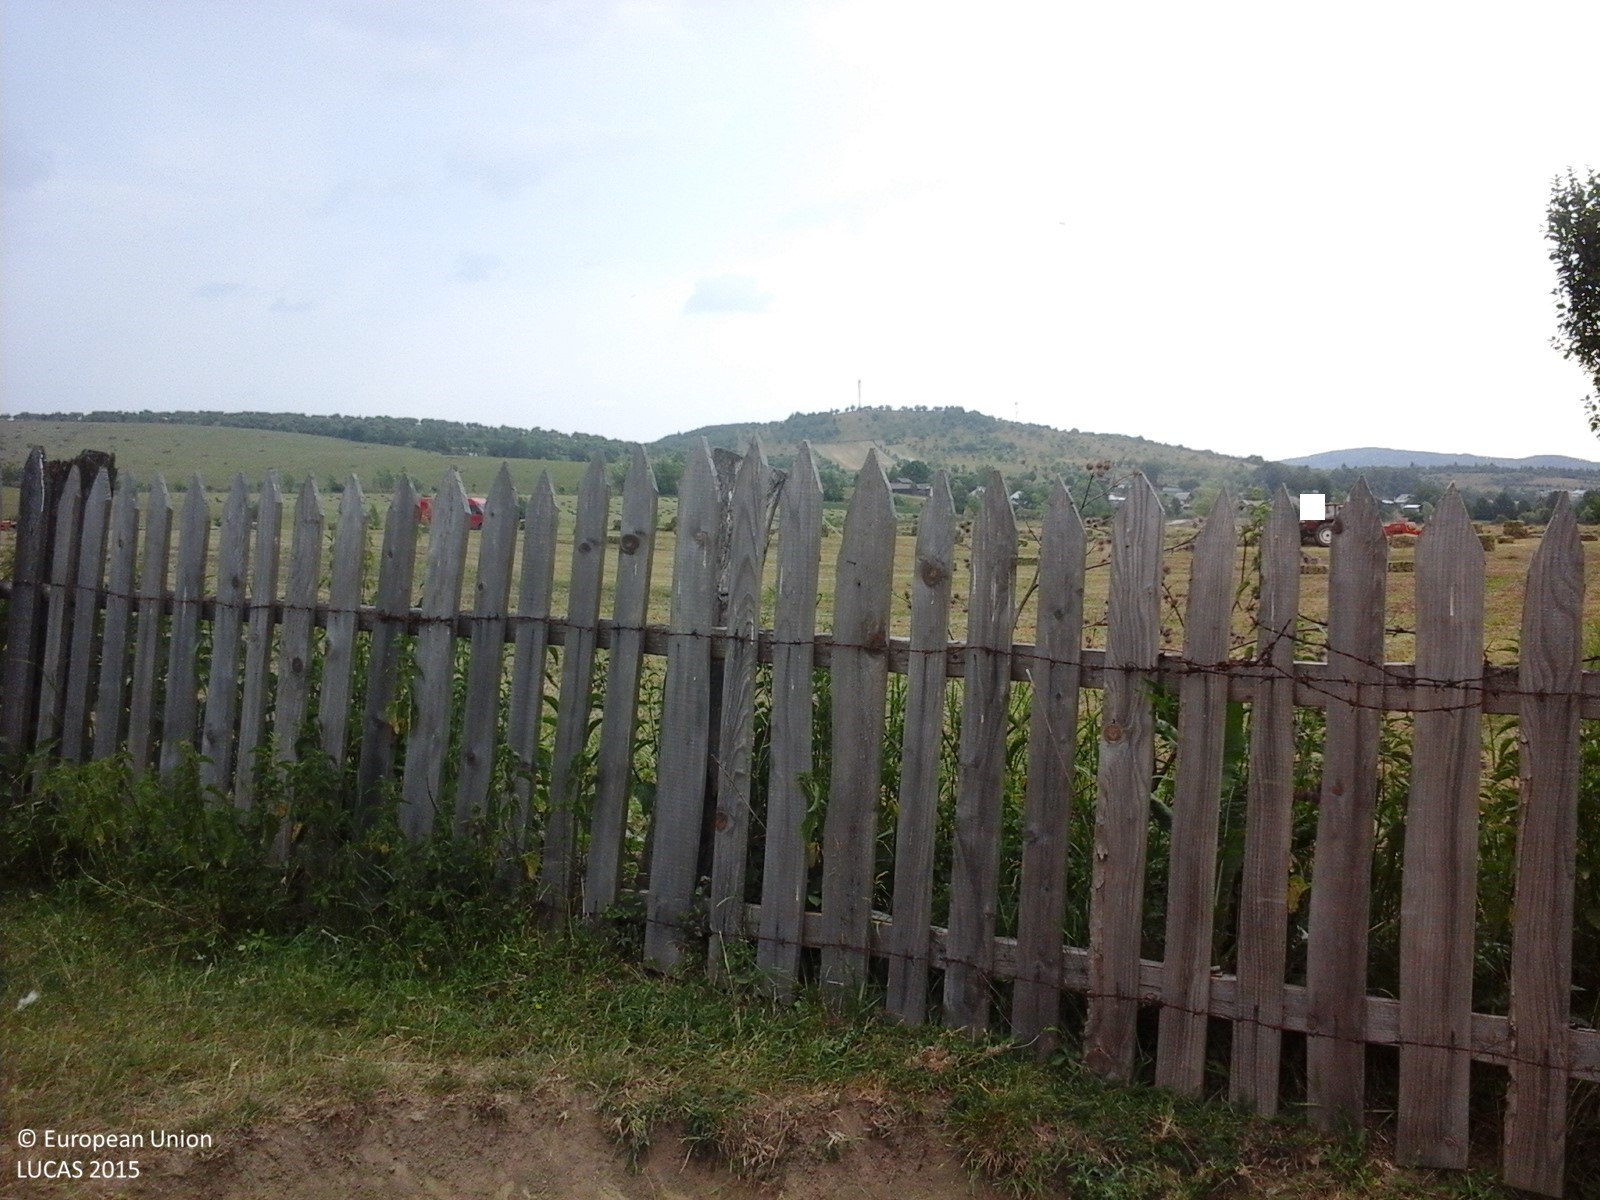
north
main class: Grassland
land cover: Grassland without tree/shrub cover
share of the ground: > 75 %
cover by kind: herbaceous plants 100 %
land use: Agriculture (excluding fallow land and kitchen gardens)
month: June
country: RO
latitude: 47.2046
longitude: 26.2792
